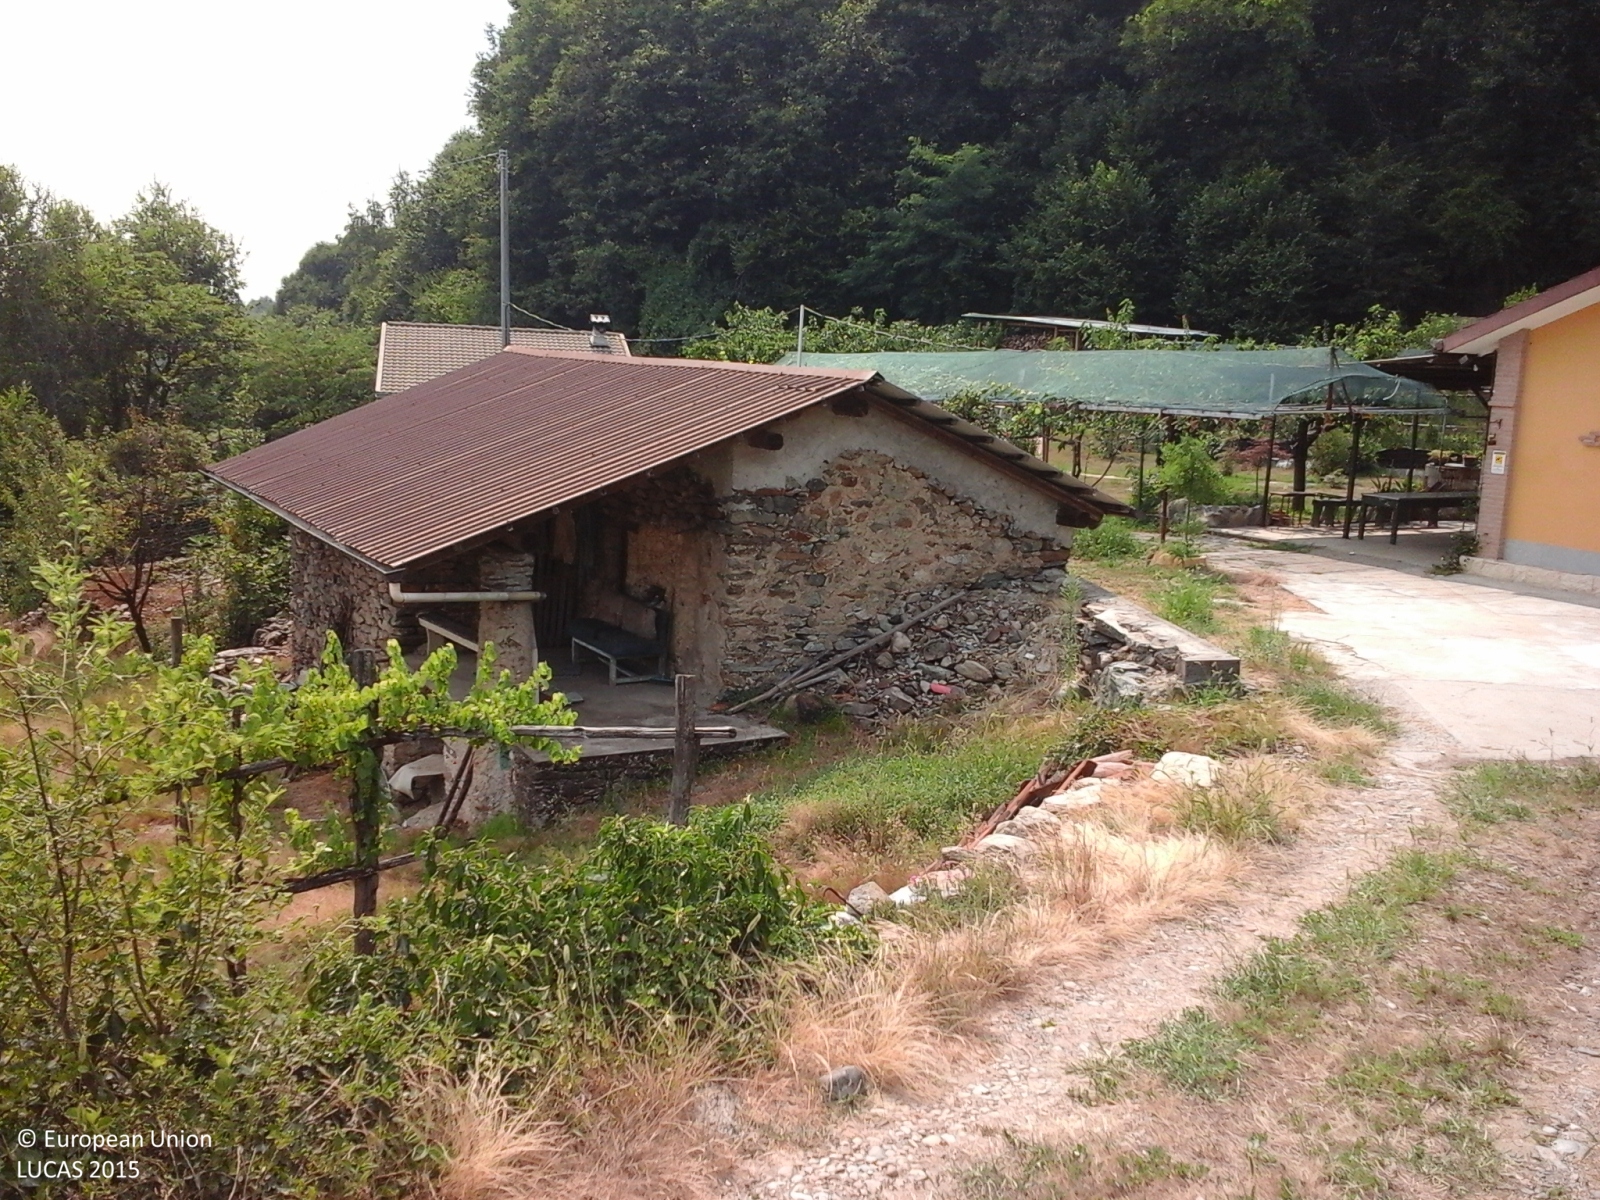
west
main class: Woodland
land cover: Broadleaved woodland
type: thermophilous deciduous forest
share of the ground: > 75 %
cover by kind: broadleaved forest trees 100 %
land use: Semi-natural and natural areas not in use
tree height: > 5 m
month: July
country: IT
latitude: 45.4267
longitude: 7.7669
